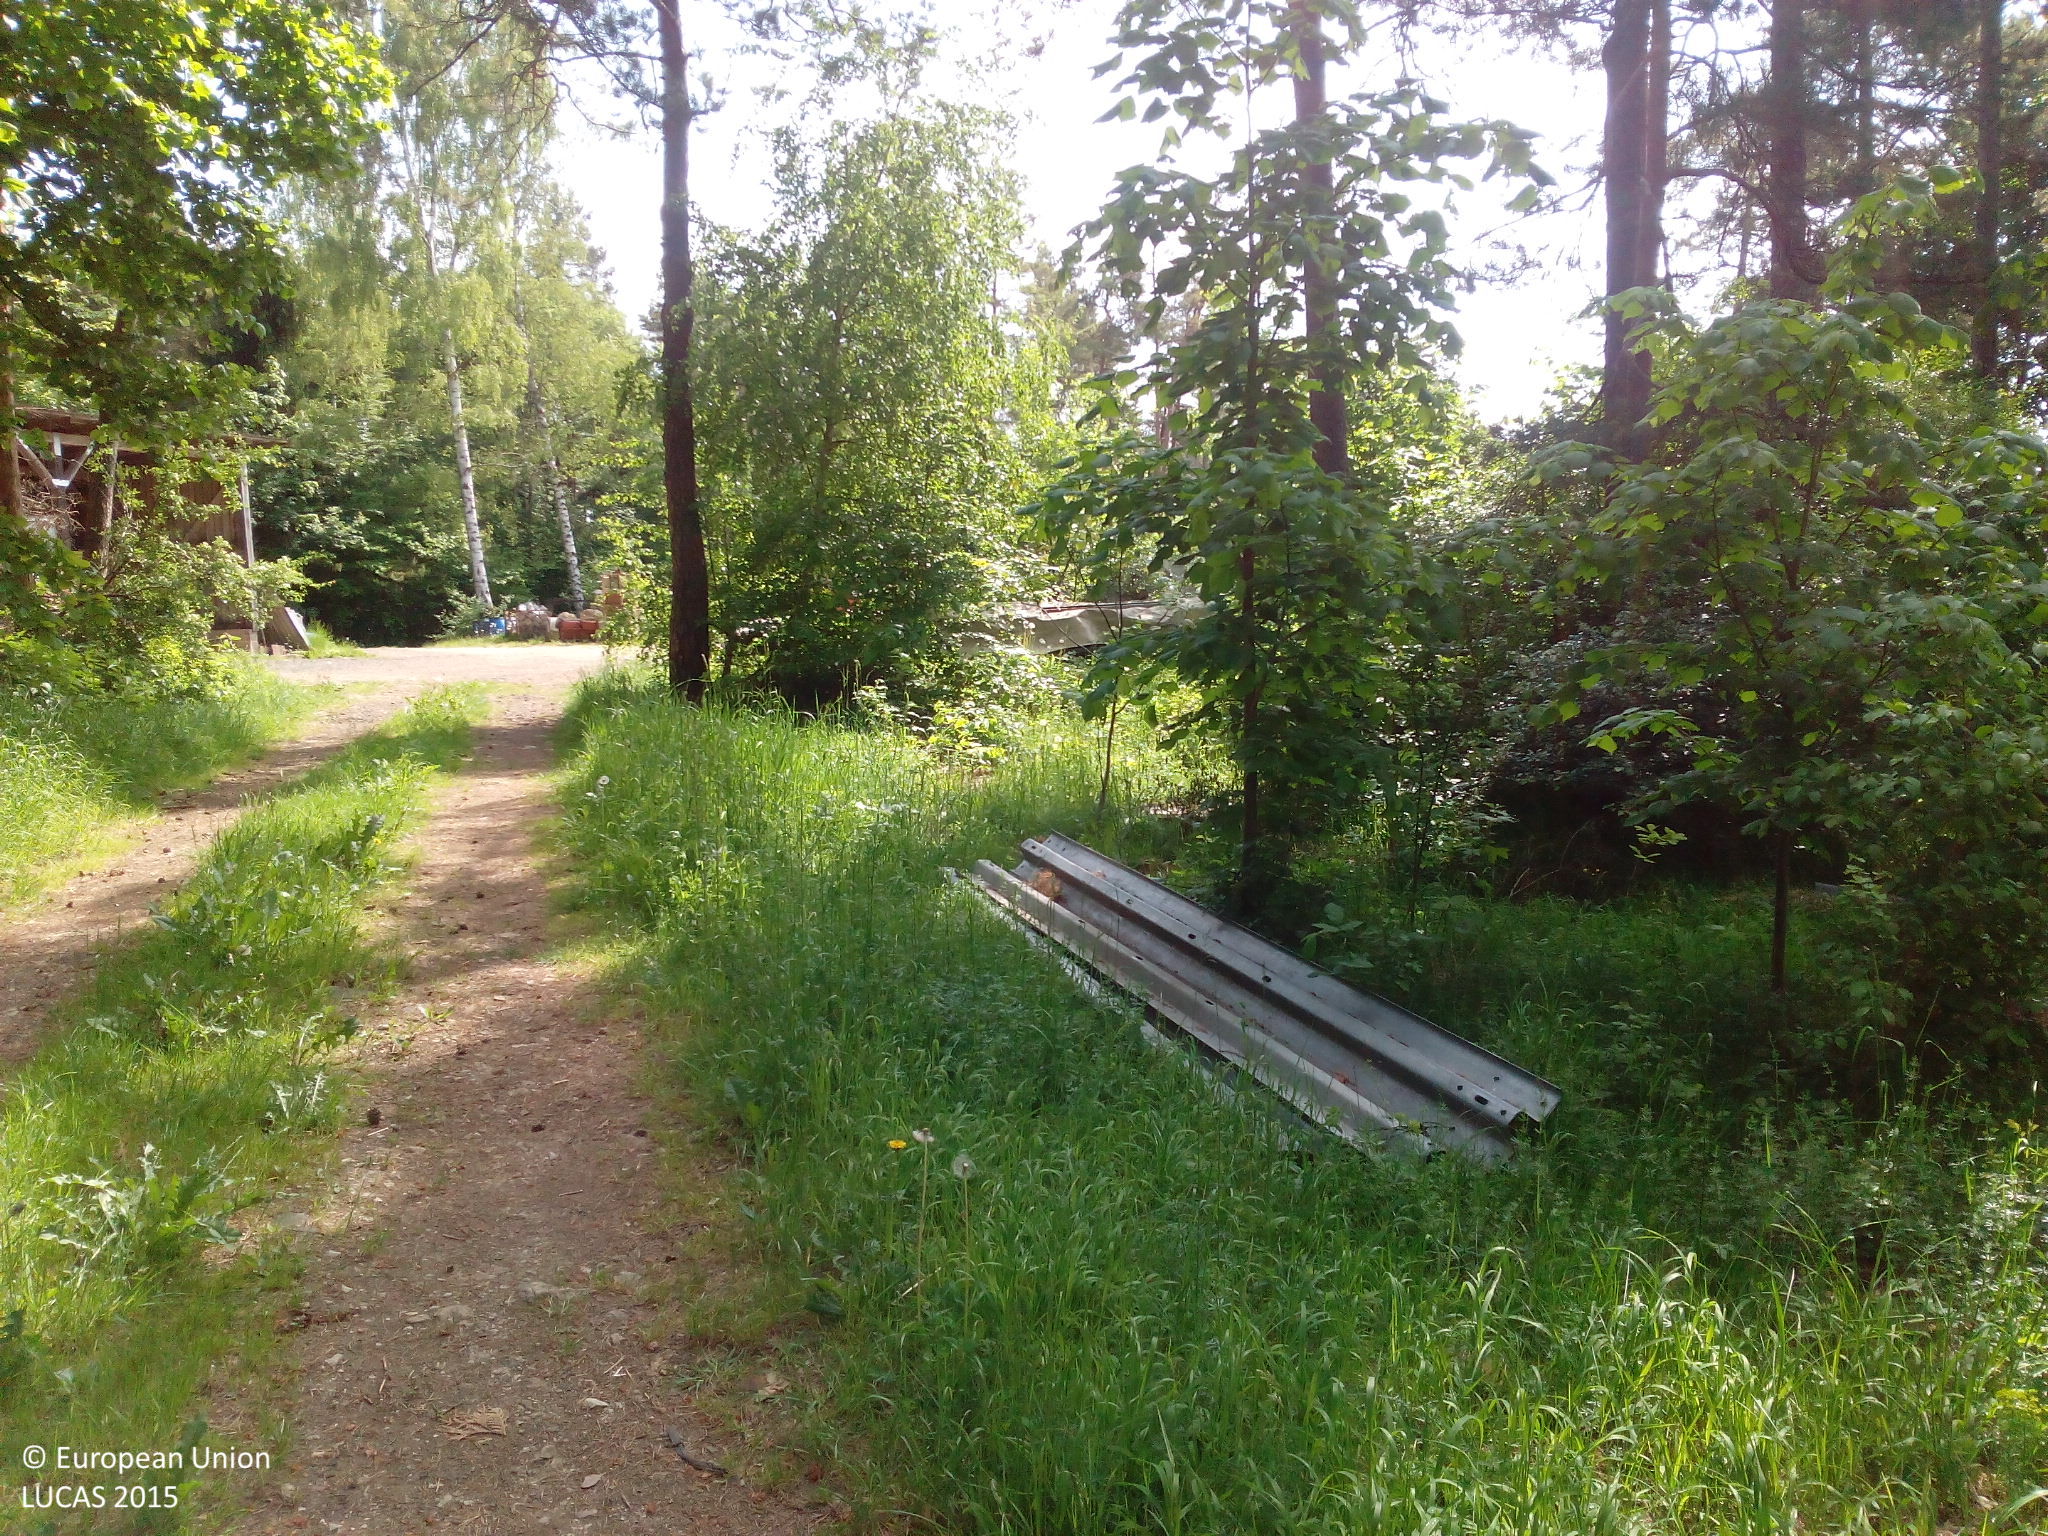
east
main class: Woodland
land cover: Other mixed woodland
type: hemiboreal forest and nemoral coniferous forest and mixed broadleaved-coniferous forest
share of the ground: > 75 %
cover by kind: coniferous forest trees 50 %, broadleaved forest trees 50 %
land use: Forestry
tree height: > 5 m
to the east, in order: Tracks; Pine dominated mixed woodland; Pine dominated coniferous woodland; Shrubland with sparse tree cover; Artificial constructions in urban areas; Other mixed woodland; Artificial constructions in urban areas; Grassland without tree/shrub cover; Fences; Grassland without tree/shrub cover; Spruce dominated mixed woodland; Grassland without tree/shrub cover
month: May
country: DE
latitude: 49.7968
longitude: 11.4861
